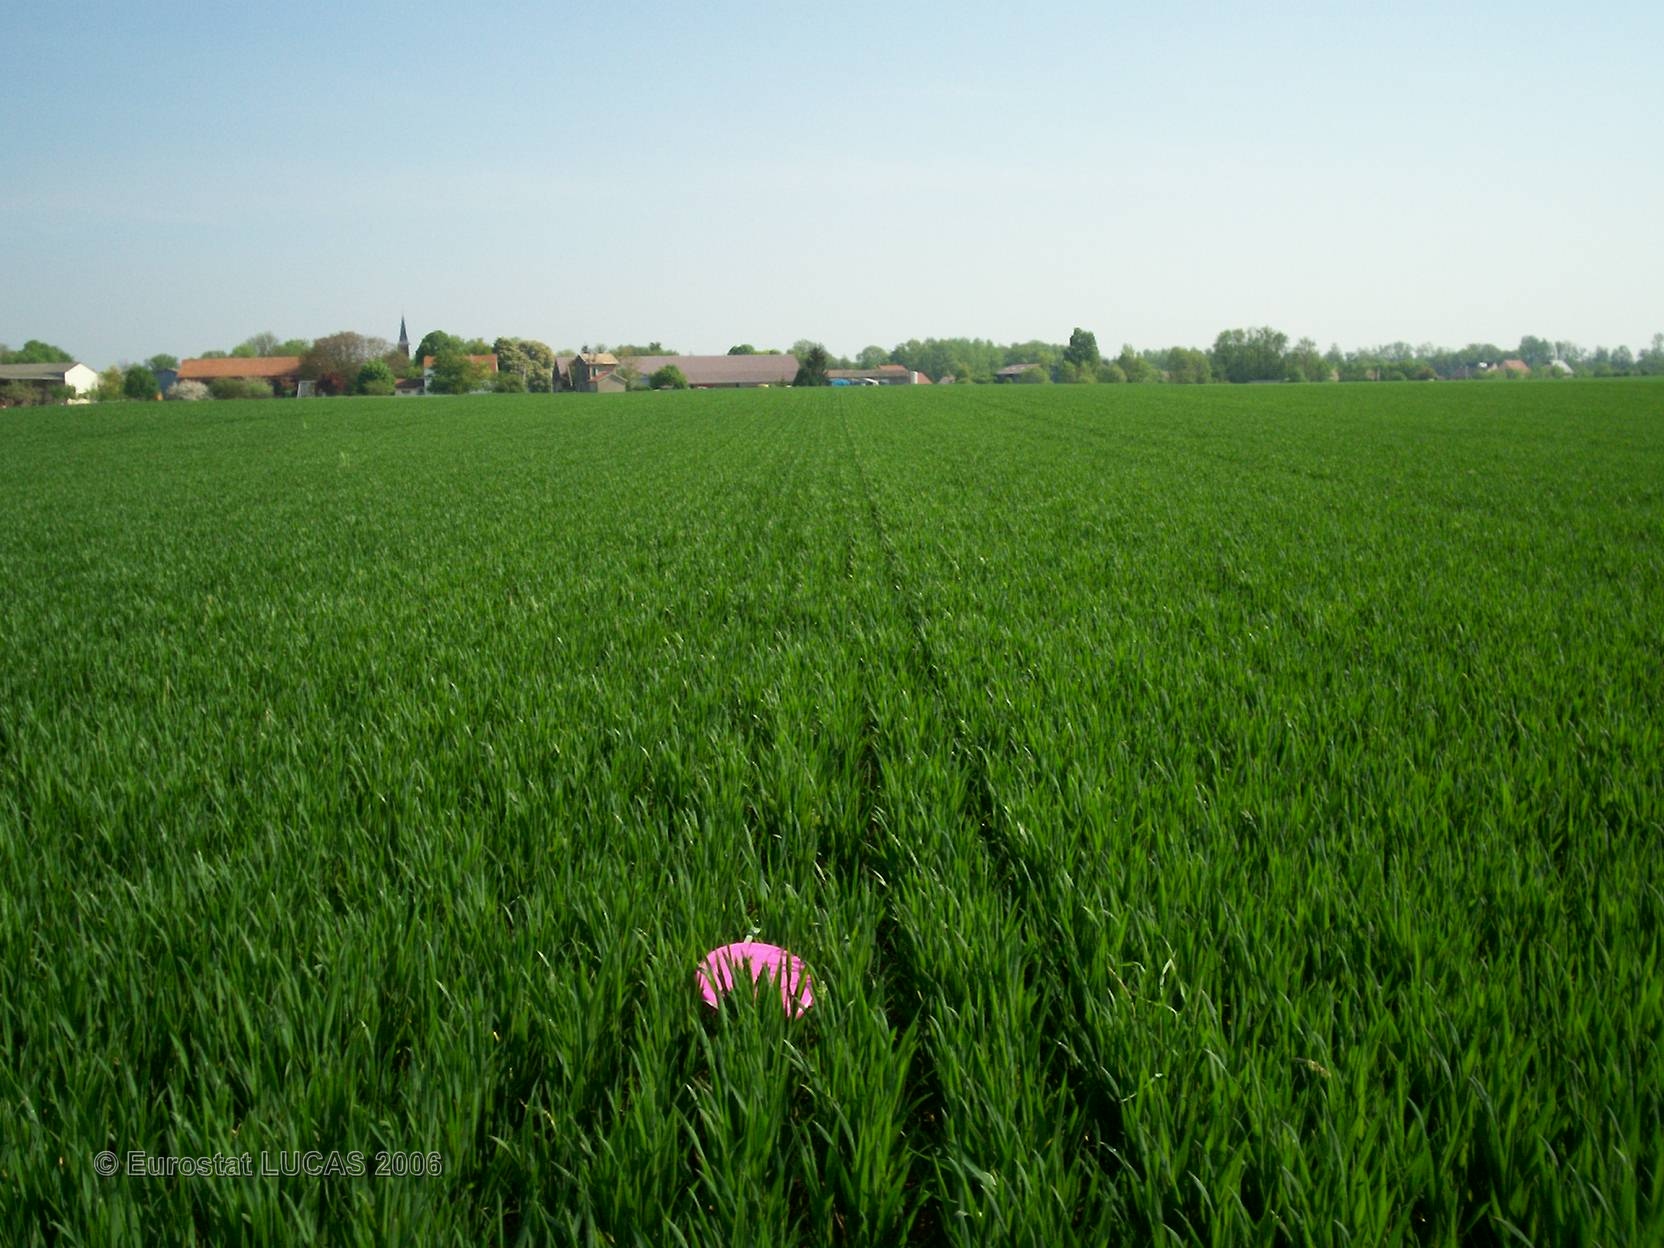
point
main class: Cropland
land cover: Common wheat
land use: Agriculture (excluding fallow land and kitchen gardens)
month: May
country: FR
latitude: 49.0564
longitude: 4.4269
